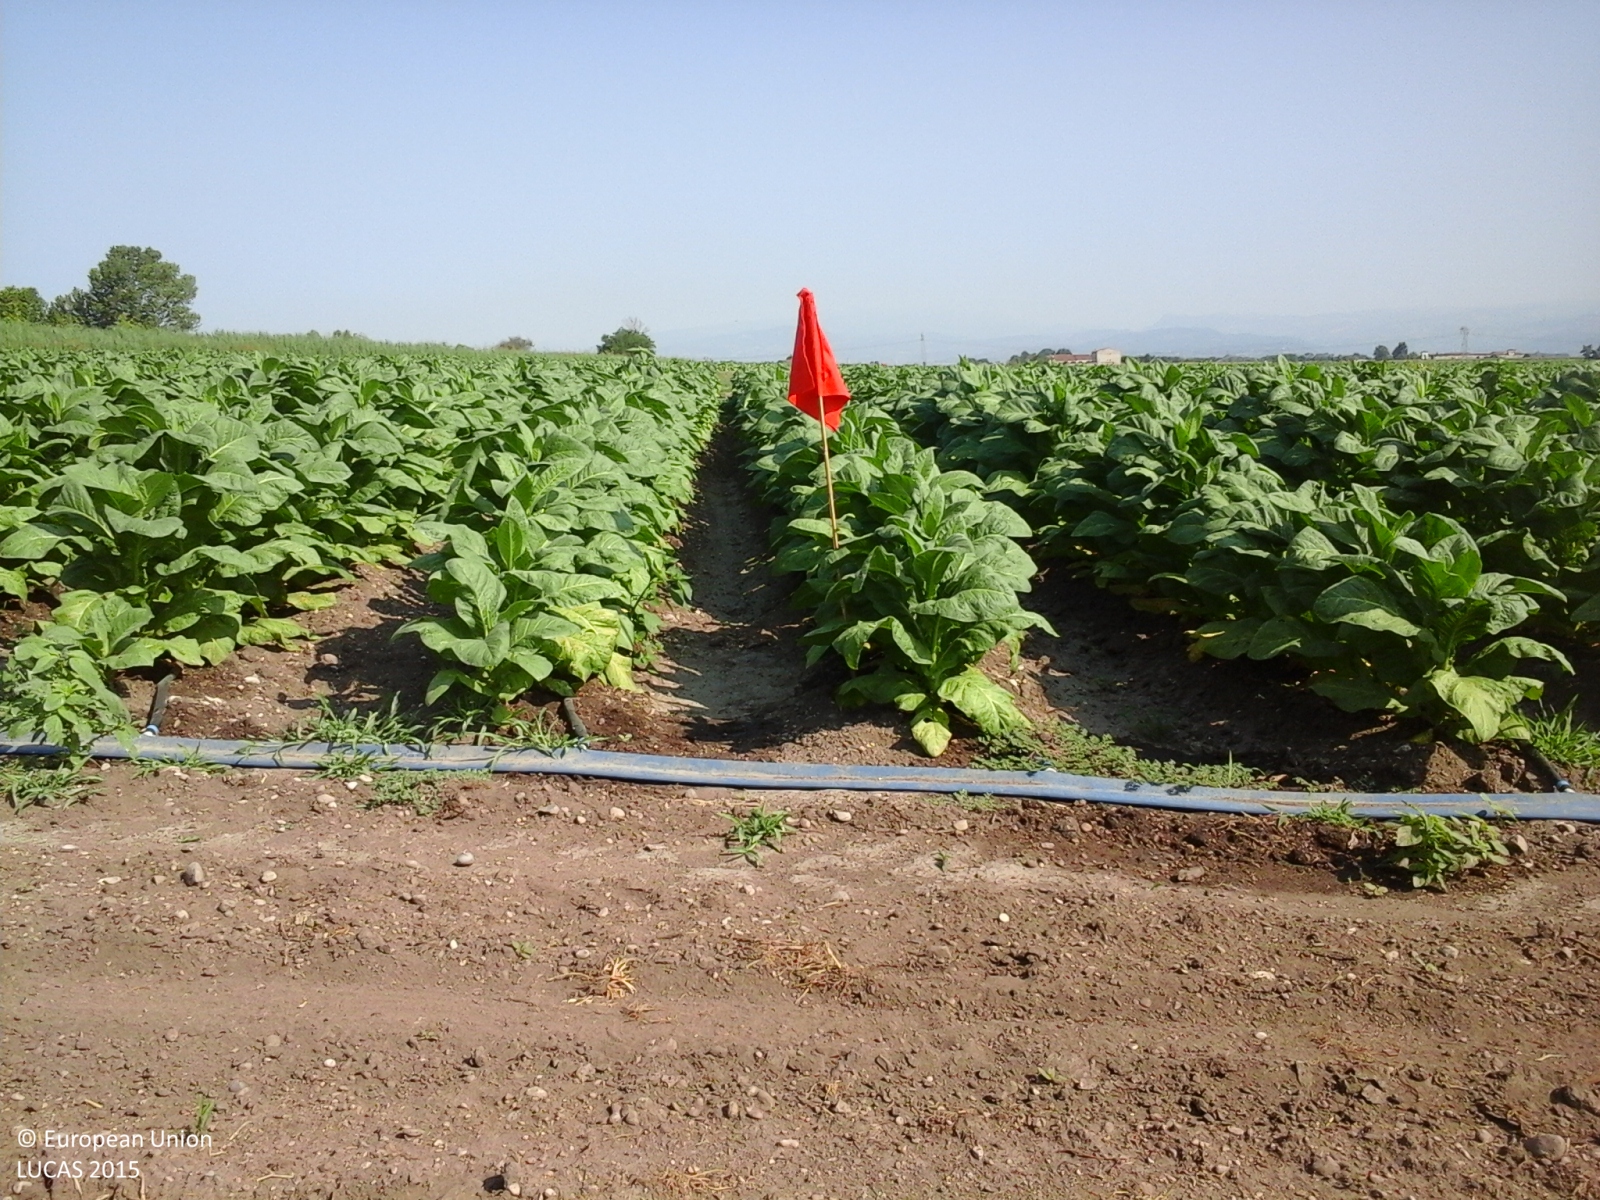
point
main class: Cropland
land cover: Tobacco
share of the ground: > 75 %
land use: Agriculture (excluding fallow land and kitchen gardens)
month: July
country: IT
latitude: 45.3191
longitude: 11.0315
